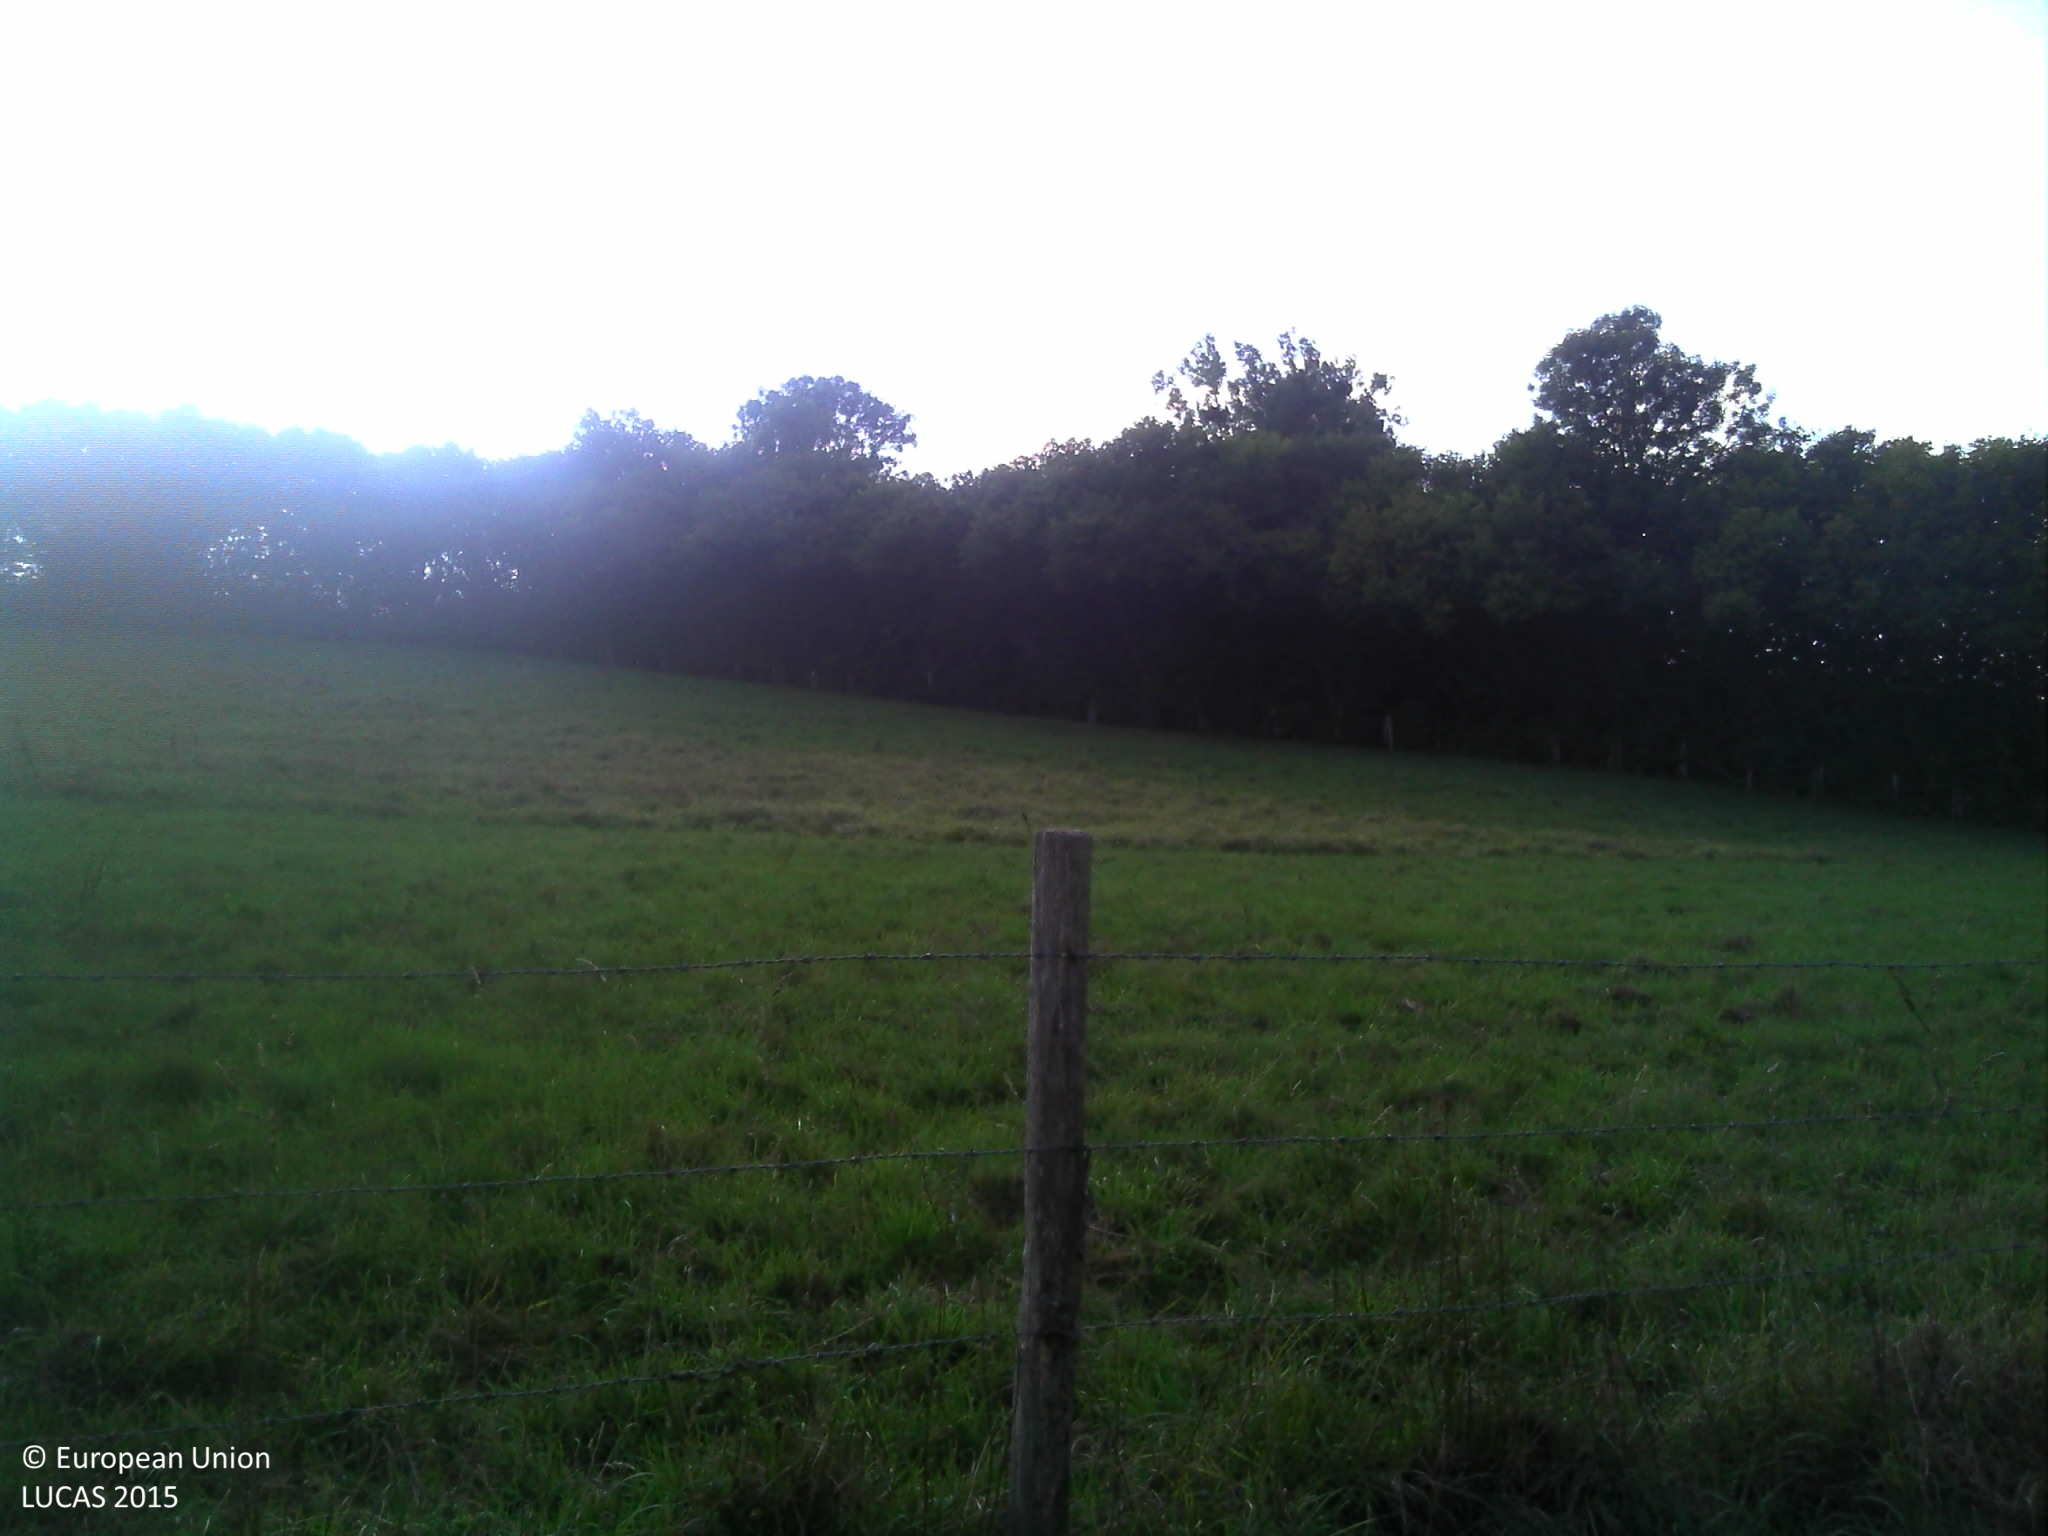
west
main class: Grassland
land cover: Grassland without tree/shrub cover
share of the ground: > 75 %
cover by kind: herbaceous plants 100 %
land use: Agriculture (excluding fallow land and kitchen gardens)
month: September
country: FR
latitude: 48.3797
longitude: 0.5653
